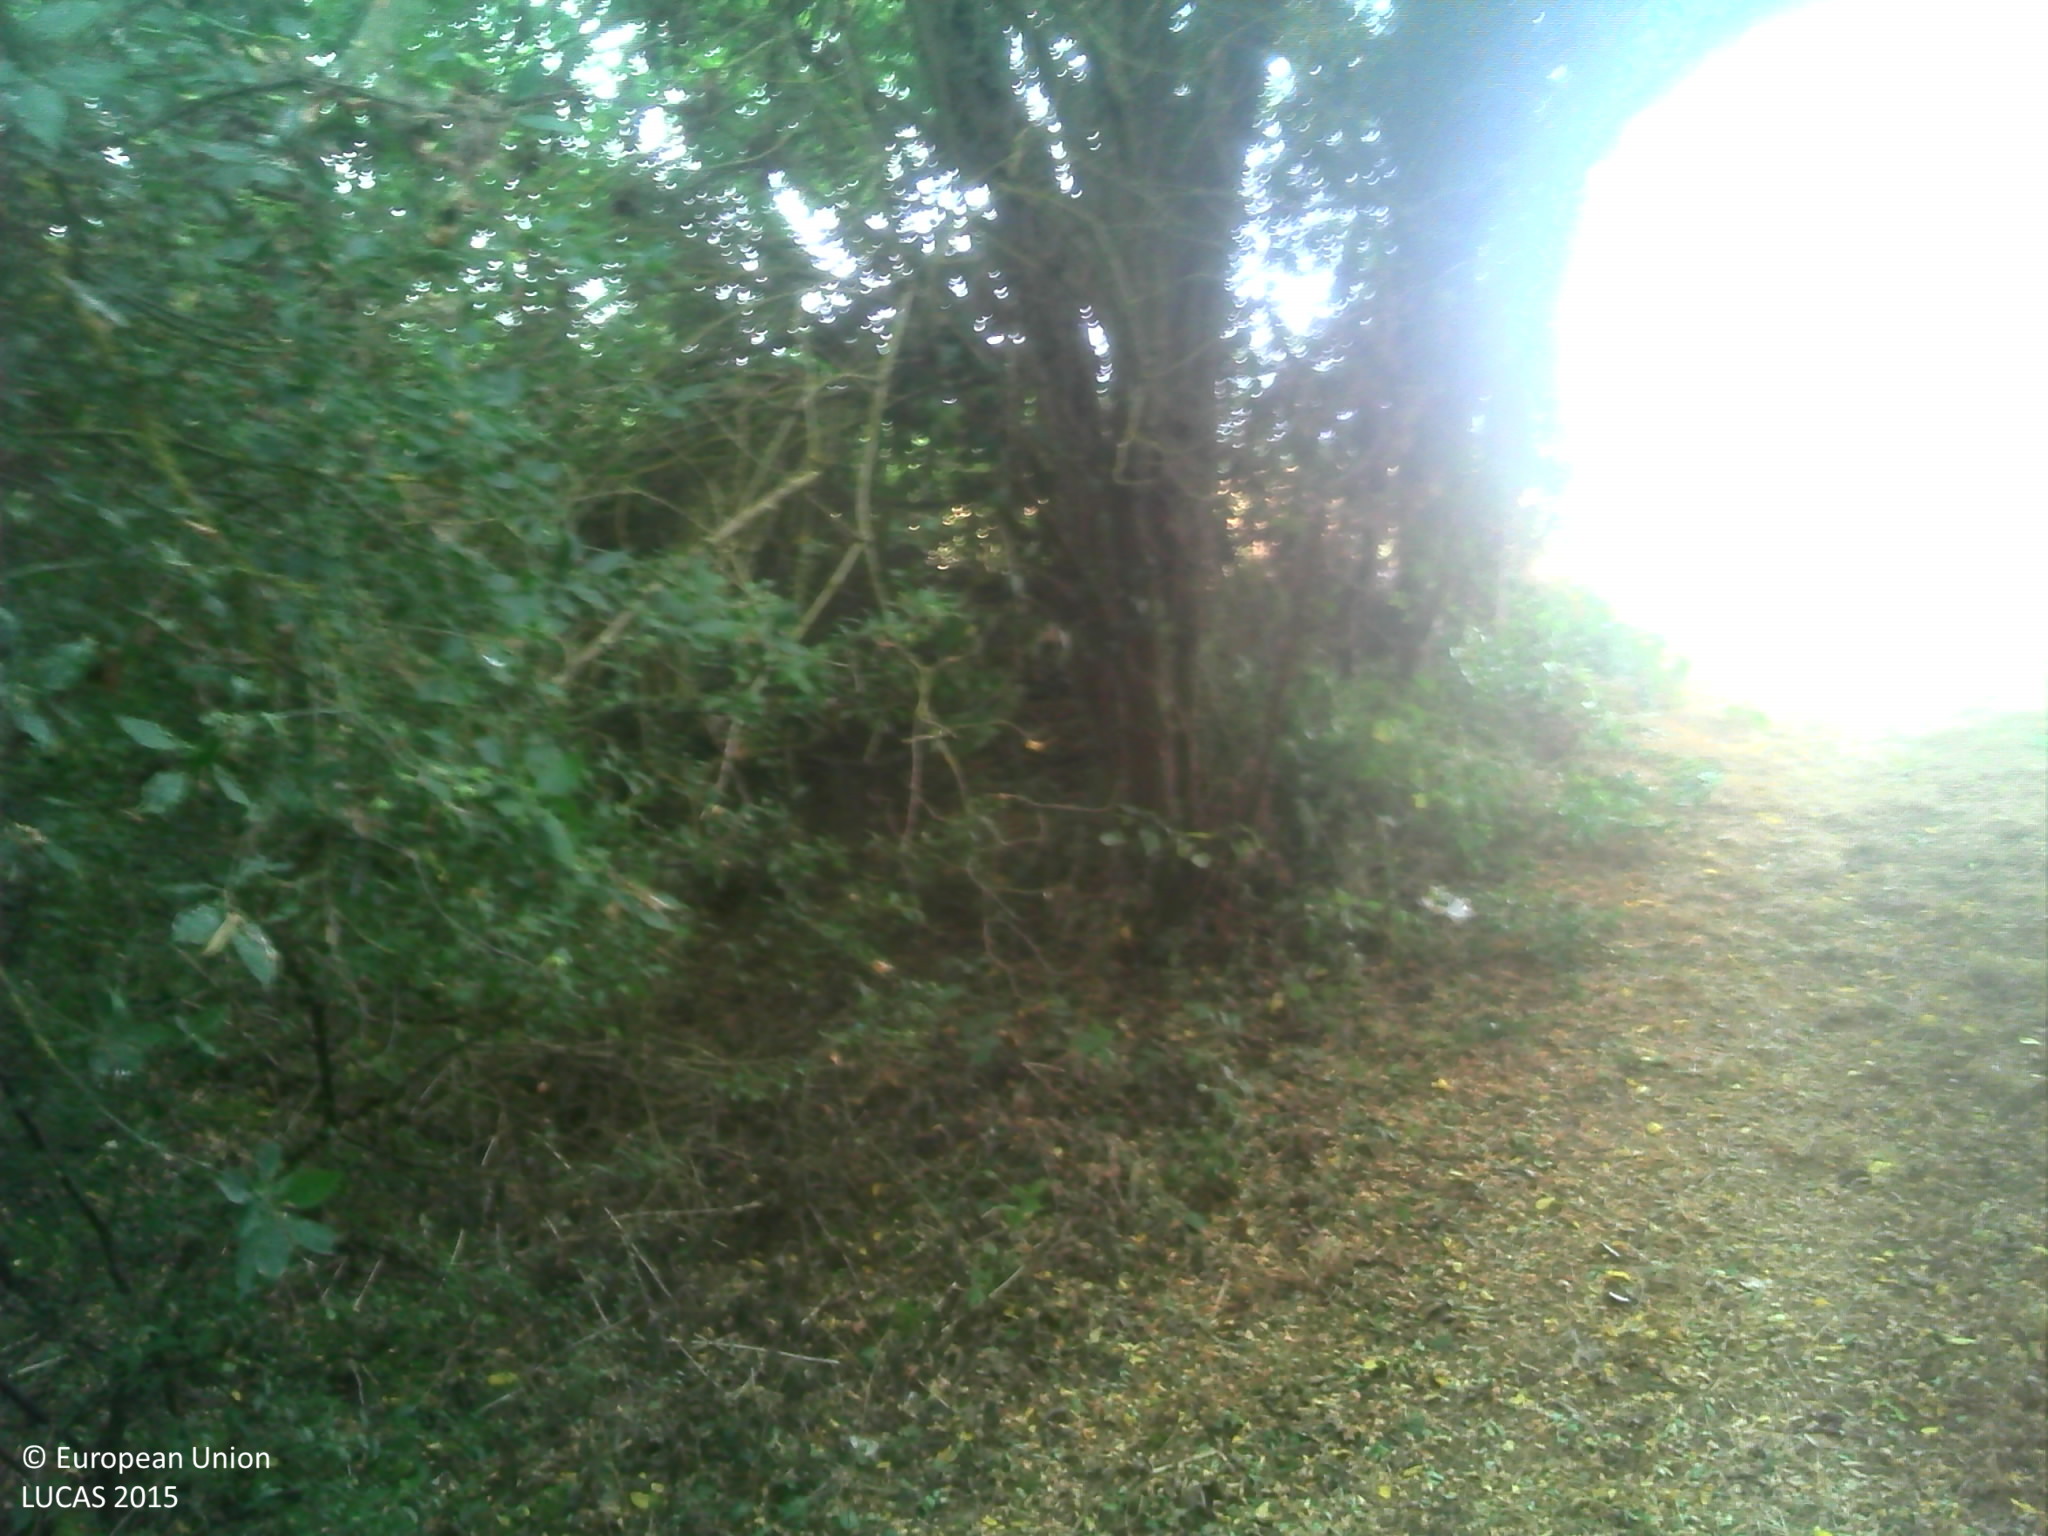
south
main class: Woodland
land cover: Broadleaved woodland
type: mesophytic deciduous forest
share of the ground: > 75 %
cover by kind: broadleaved forest trees 50 %, herbaceous plants 50 %
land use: Semi-natural and natural areas not in use
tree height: > 5 m
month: July
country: FR
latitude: 47.7167
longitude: 1.3062
